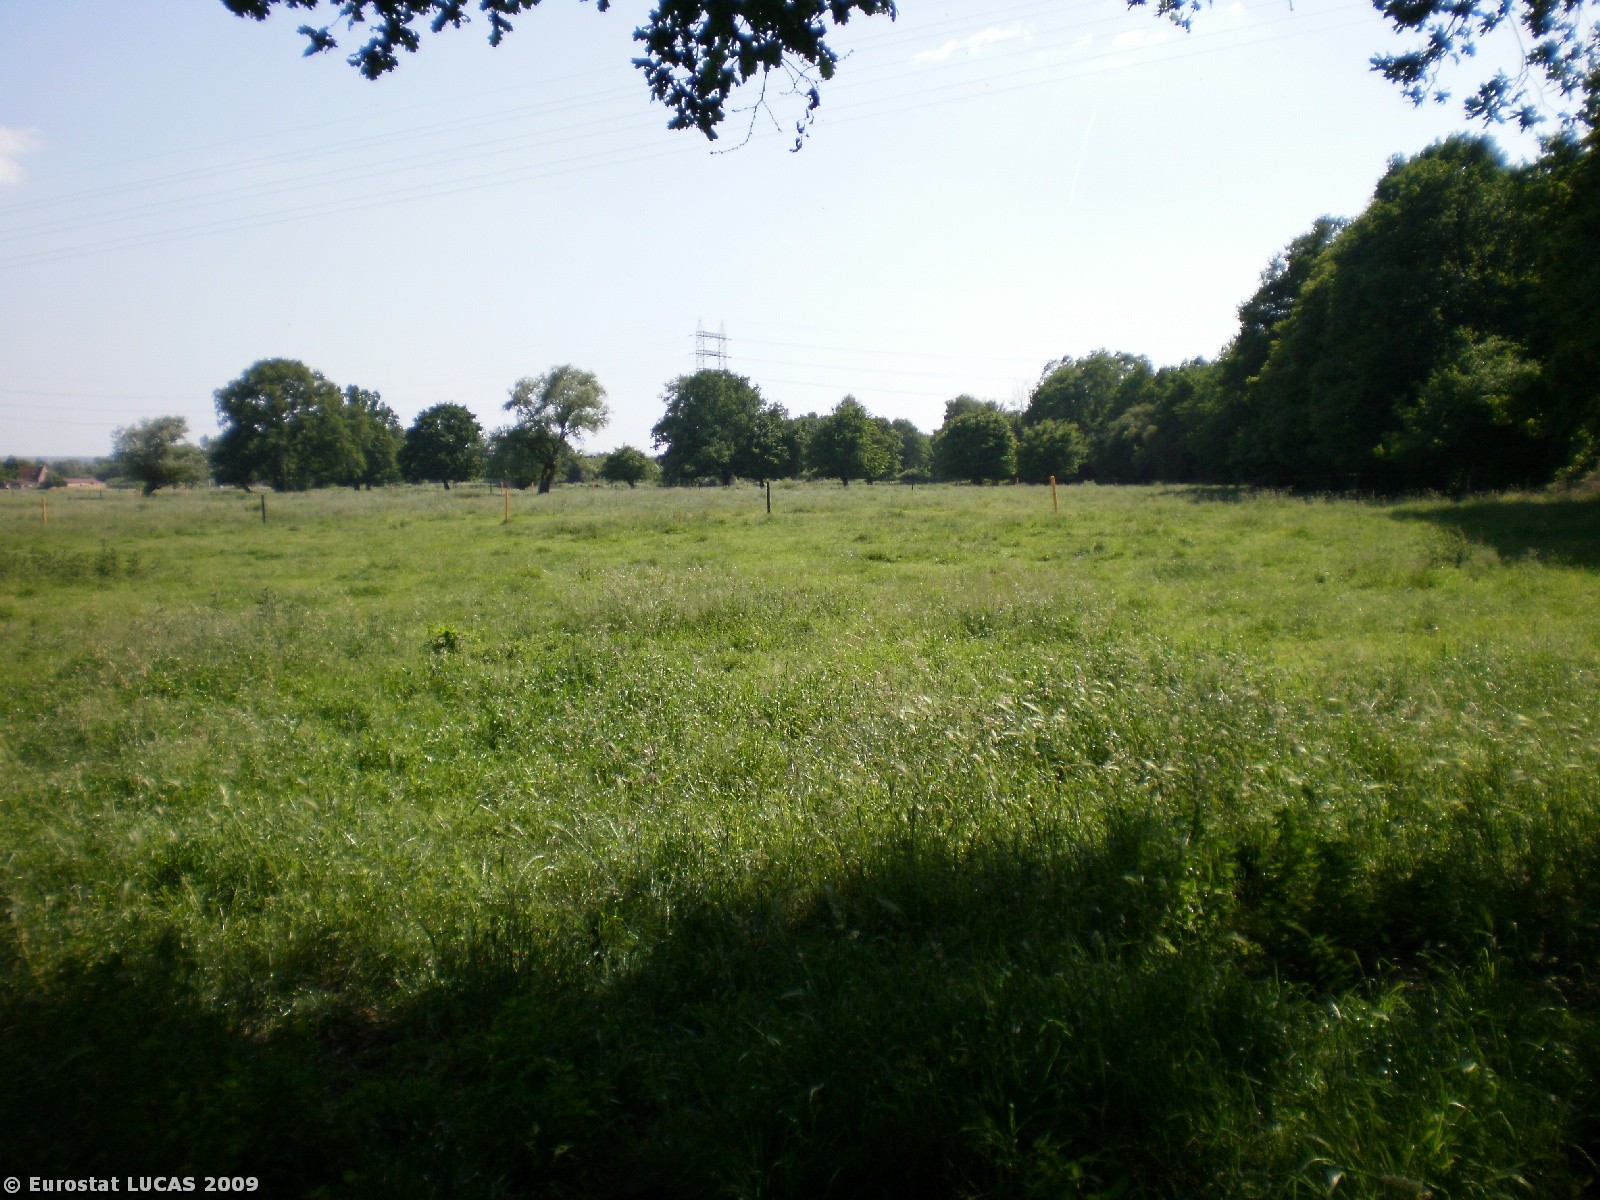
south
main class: Grassland
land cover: Grassland without tree/shrub cover
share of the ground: > 75 %
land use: Agriculture (excluding fallow land and kitchen gardens)
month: June
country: BE
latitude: 50.4684
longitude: 3.8368
